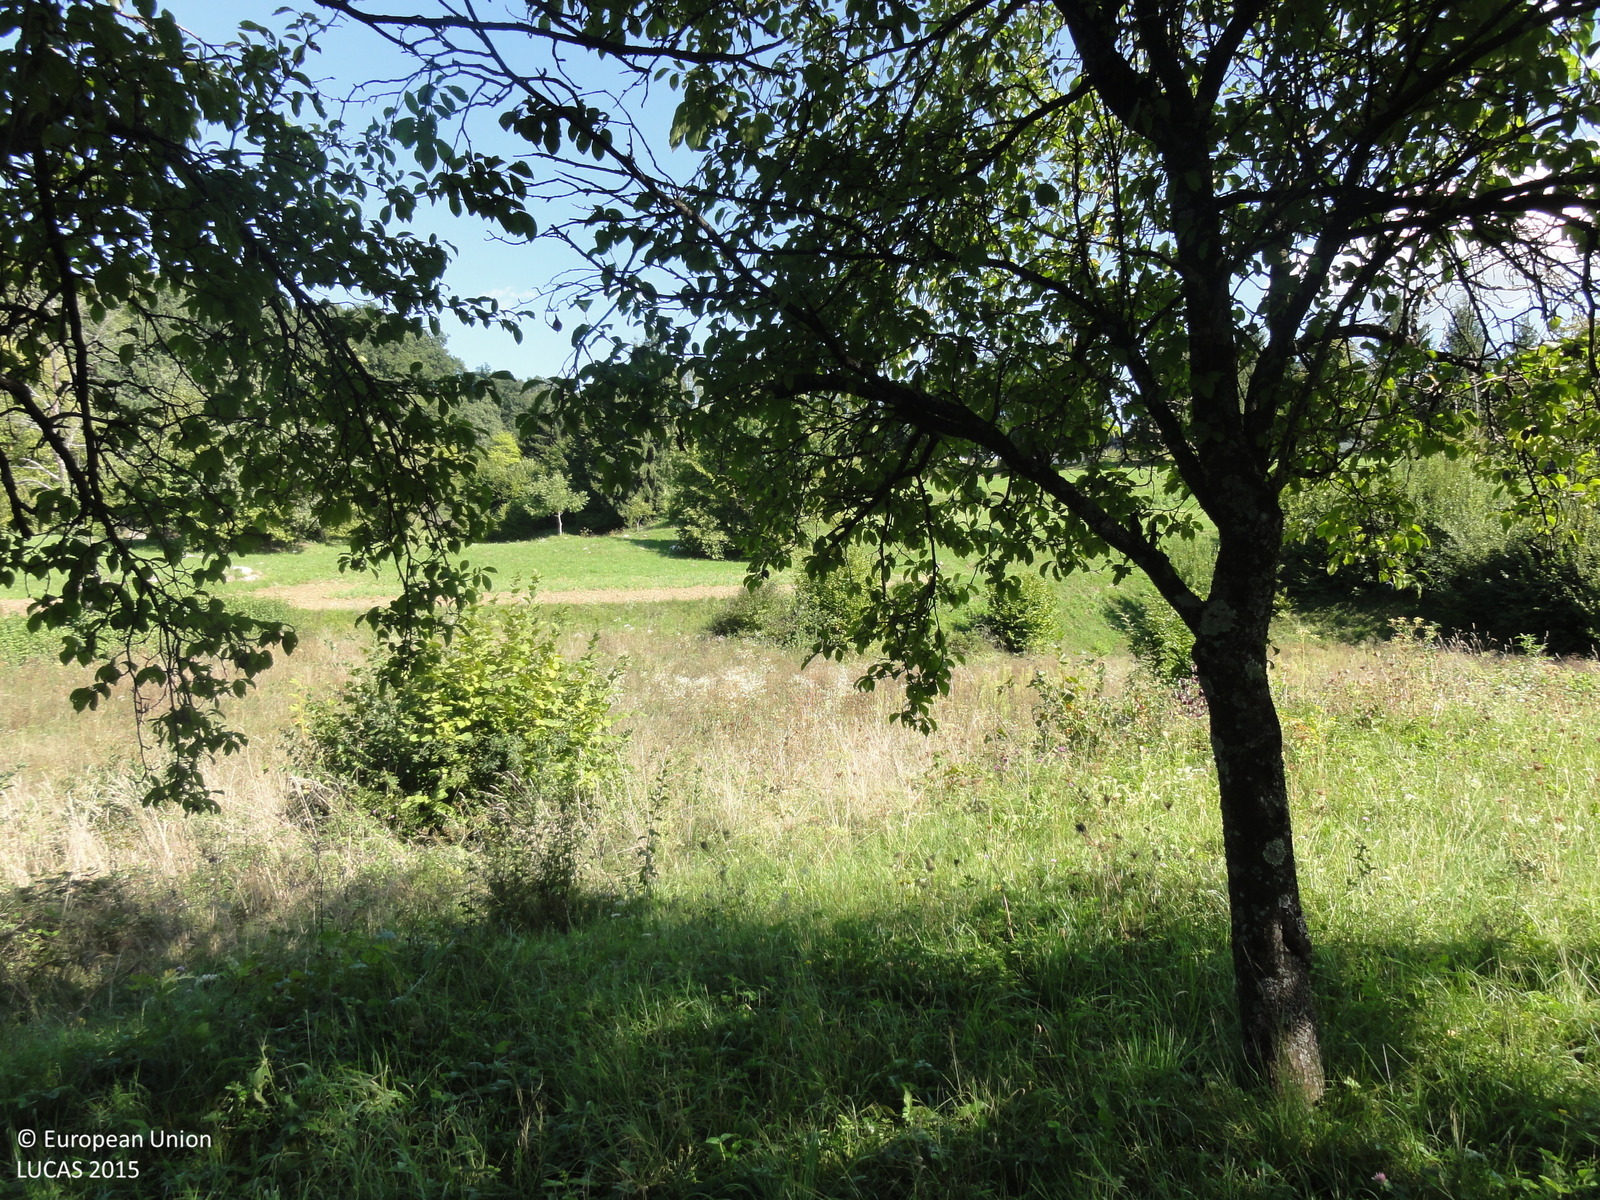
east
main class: Grassland
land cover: Grassland with sparse tree/shrub cover
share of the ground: > 75 %
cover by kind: herbaceous plants 90 %, broadleaved forest trees 5 %, shrubs 5 %
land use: Agriculture (excluding fallow land and kitchen gardens)
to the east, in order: Grassland with sparse tree/shrub cover; Potatoes; Grassland with sparse tree/shrub cover; Other fresh vegetables; Tracks; Grassland with sparse tree/shrub cover; Abandoned hedges; Grassland without tree/shrub cover; Broadleaved woodland; Electric lines; Shrubland with sparse tree cover; Other bare soil; Grassland with sparse tree/shrub cover; Artificial constructions in urban areas; Grassland with sparse tree/shrub cover
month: September
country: SI
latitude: 45.8335
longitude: 15.4426
